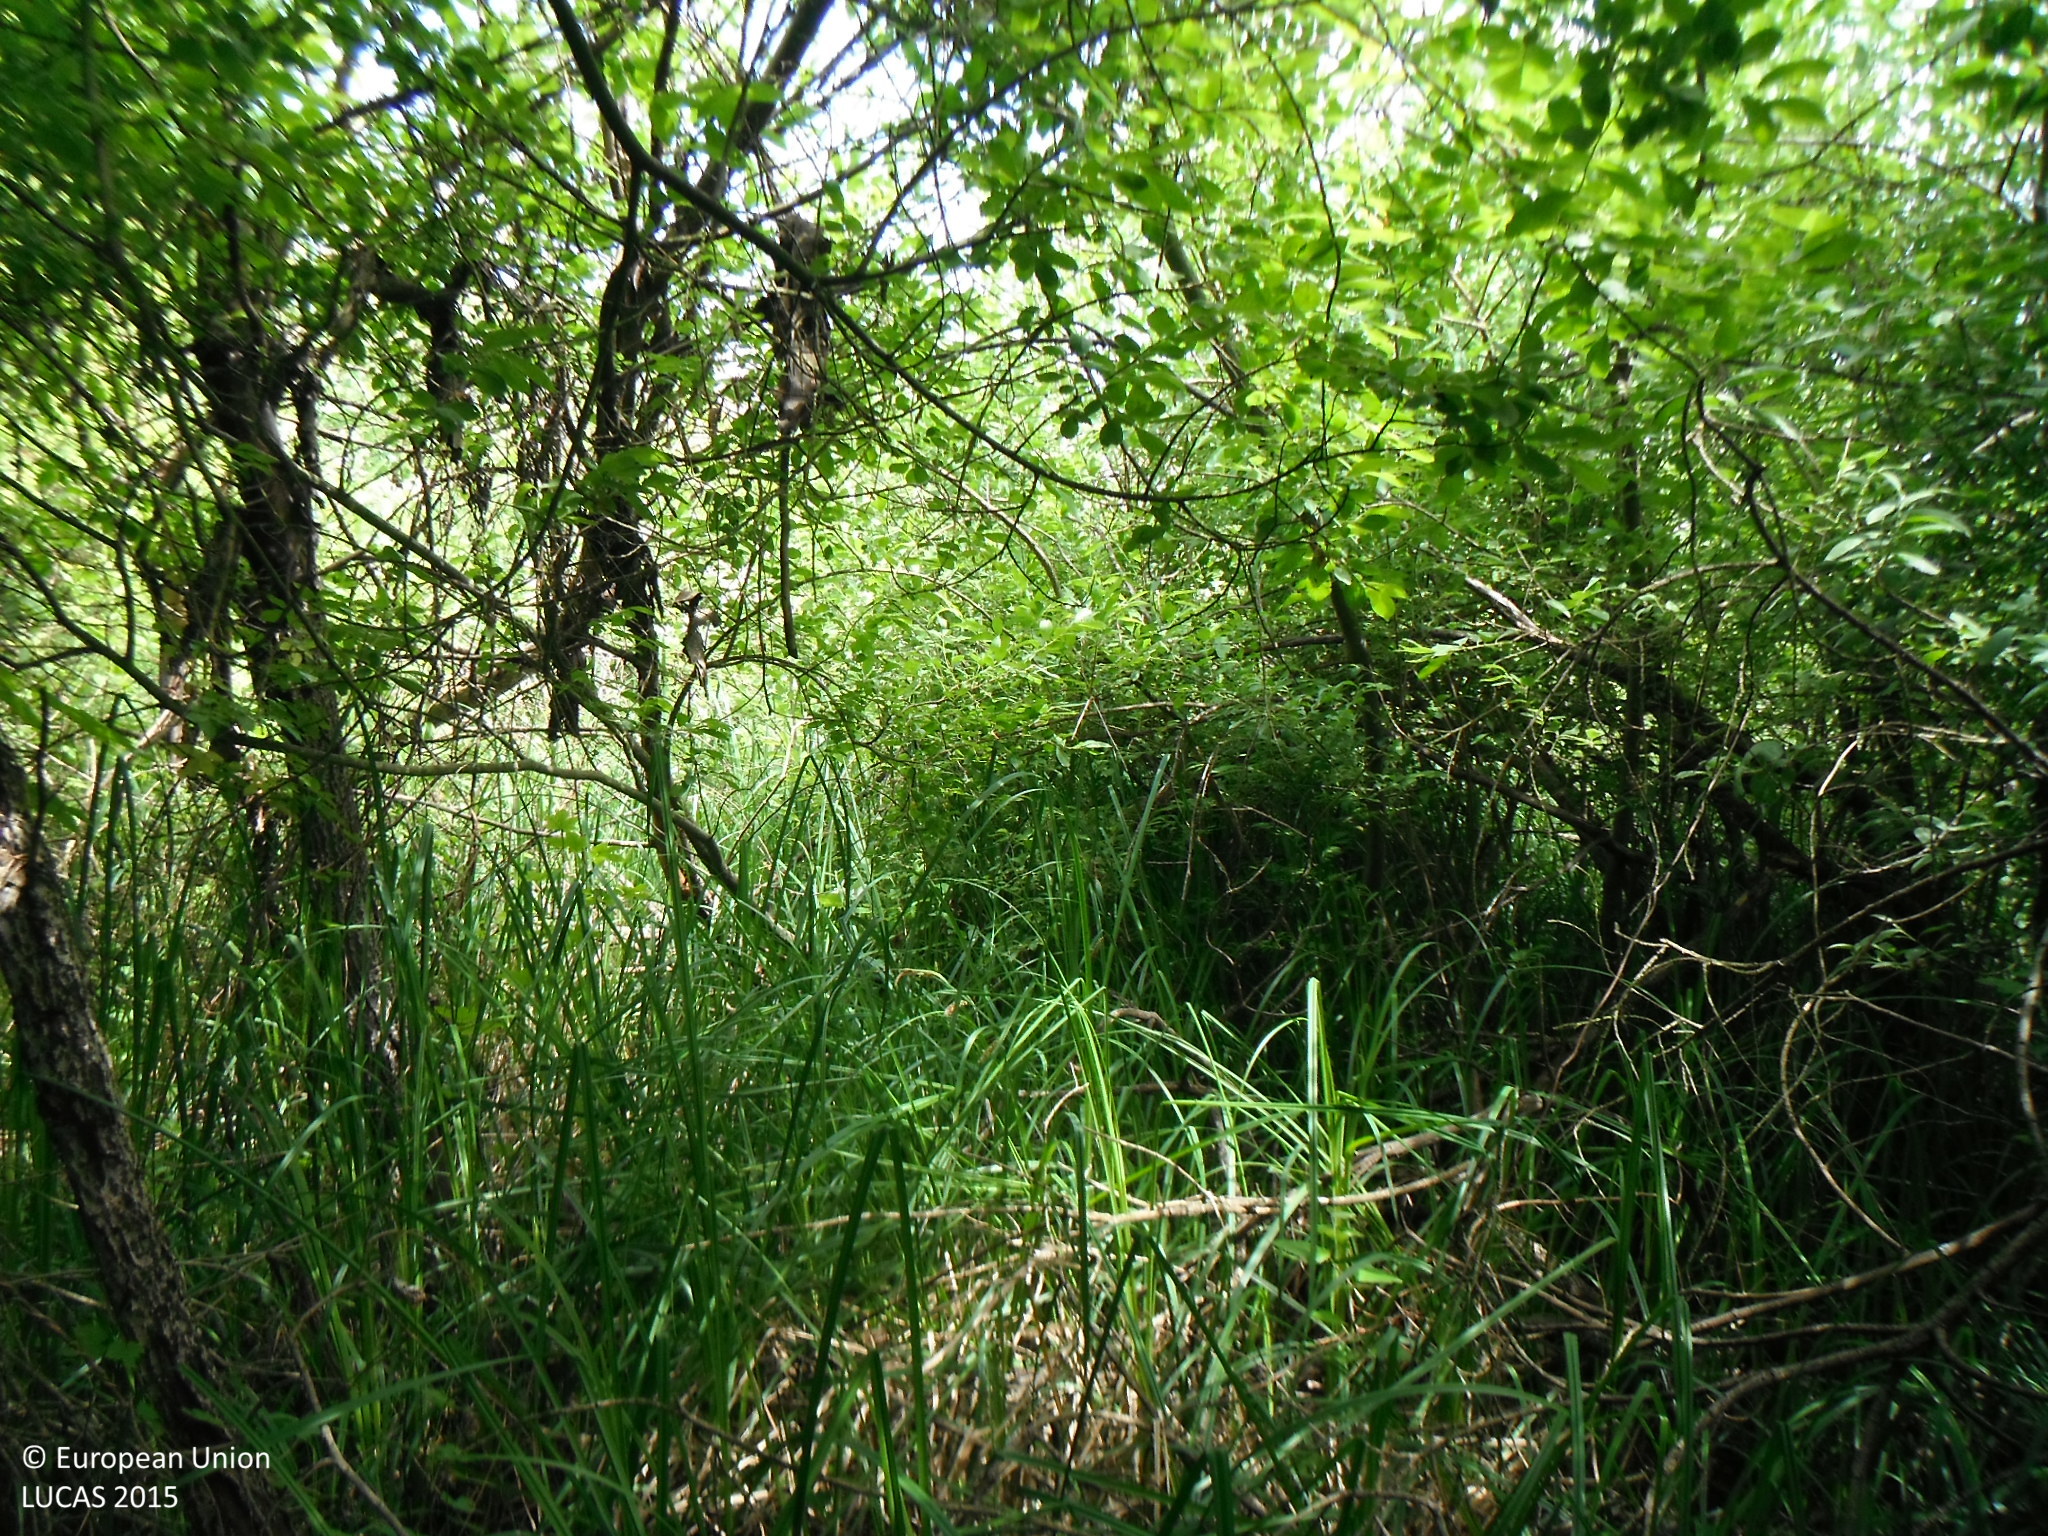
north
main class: Woodland
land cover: Broadleaved woodland
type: mesophytic deciduous forest
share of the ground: 50 - 75 %
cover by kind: broadleaved forest trees 55 %, shrubs 45 %
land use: Semi-natural and natural areas not in use
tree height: > 5 m
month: June
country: SK
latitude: 47.9165
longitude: 18.2160
